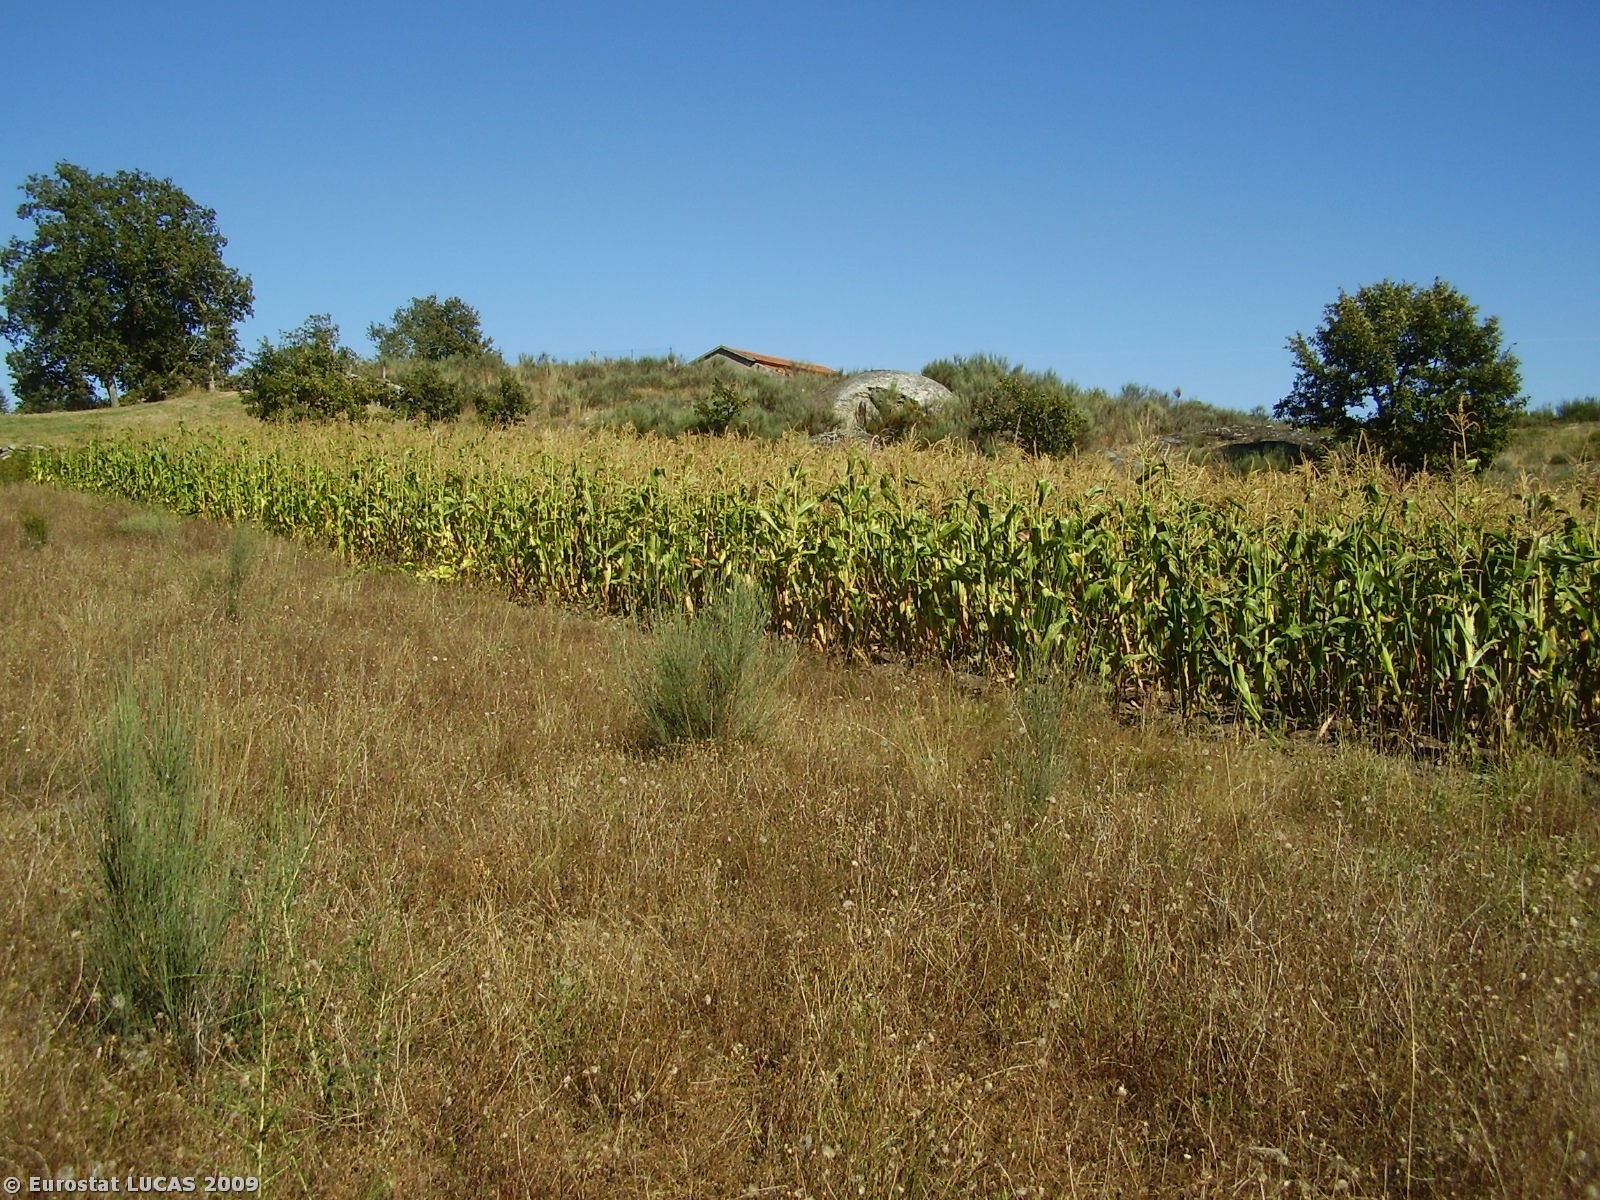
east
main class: Grassland
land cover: Spontaneously vegetated surfaces
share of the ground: > 75 %
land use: Fallow land
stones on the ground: 10 - 25 %
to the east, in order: Spontaneously vegetated surfaces; Maize; Shrubland with sparse tree cover; Rock outcrops; Dry stone walls; Maize; Artificial constructions in urban areas; Tracks; Shrubland without tree cover; Dry stone walls; Grassland without tree/shrub cover
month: September
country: PT
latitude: 41.8089
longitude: -7.6496
